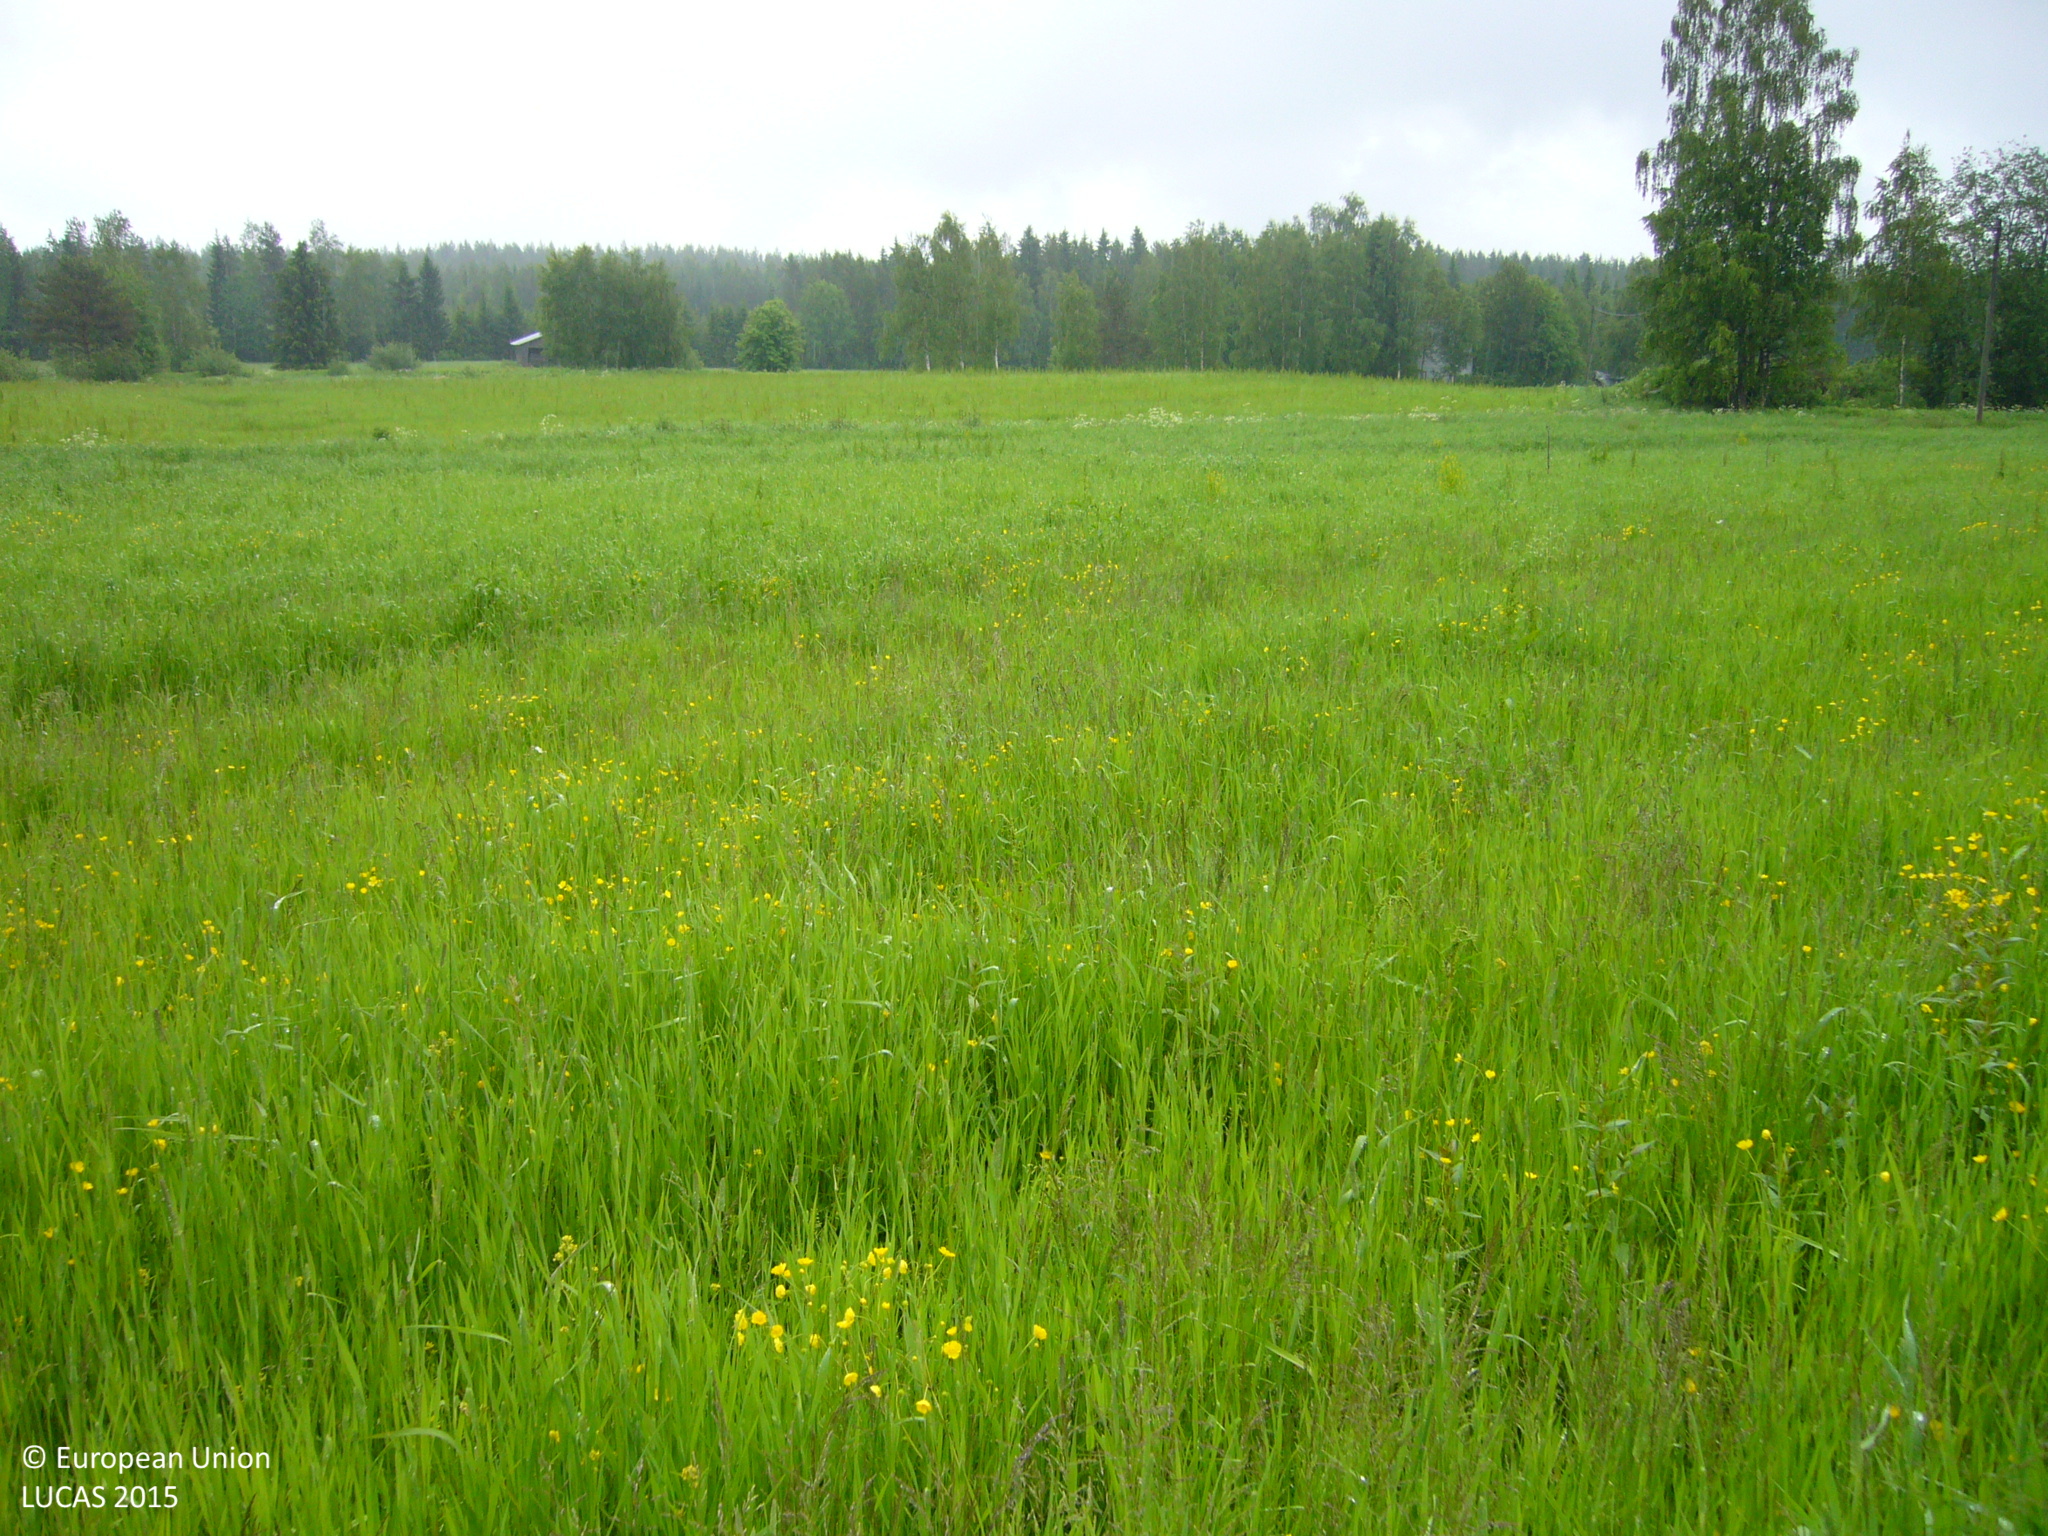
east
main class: Cropland
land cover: Temporary grasslands
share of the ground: > 75 %
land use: Agriculture (excluding fallow land and kitchen gardens)
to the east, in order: Temporary grasslands; Ditches and canals; Temporary grasslands; Ditches and canals; Paved roads, cycling and walking lanes; Grass margins; Ditches and canals; Electric lines; Broadleaved woodland; Other root crops; Ditches and canals; Grass margins; Temporary grasslands
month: June
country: FI
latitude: 63.6877
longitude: 26.1917
